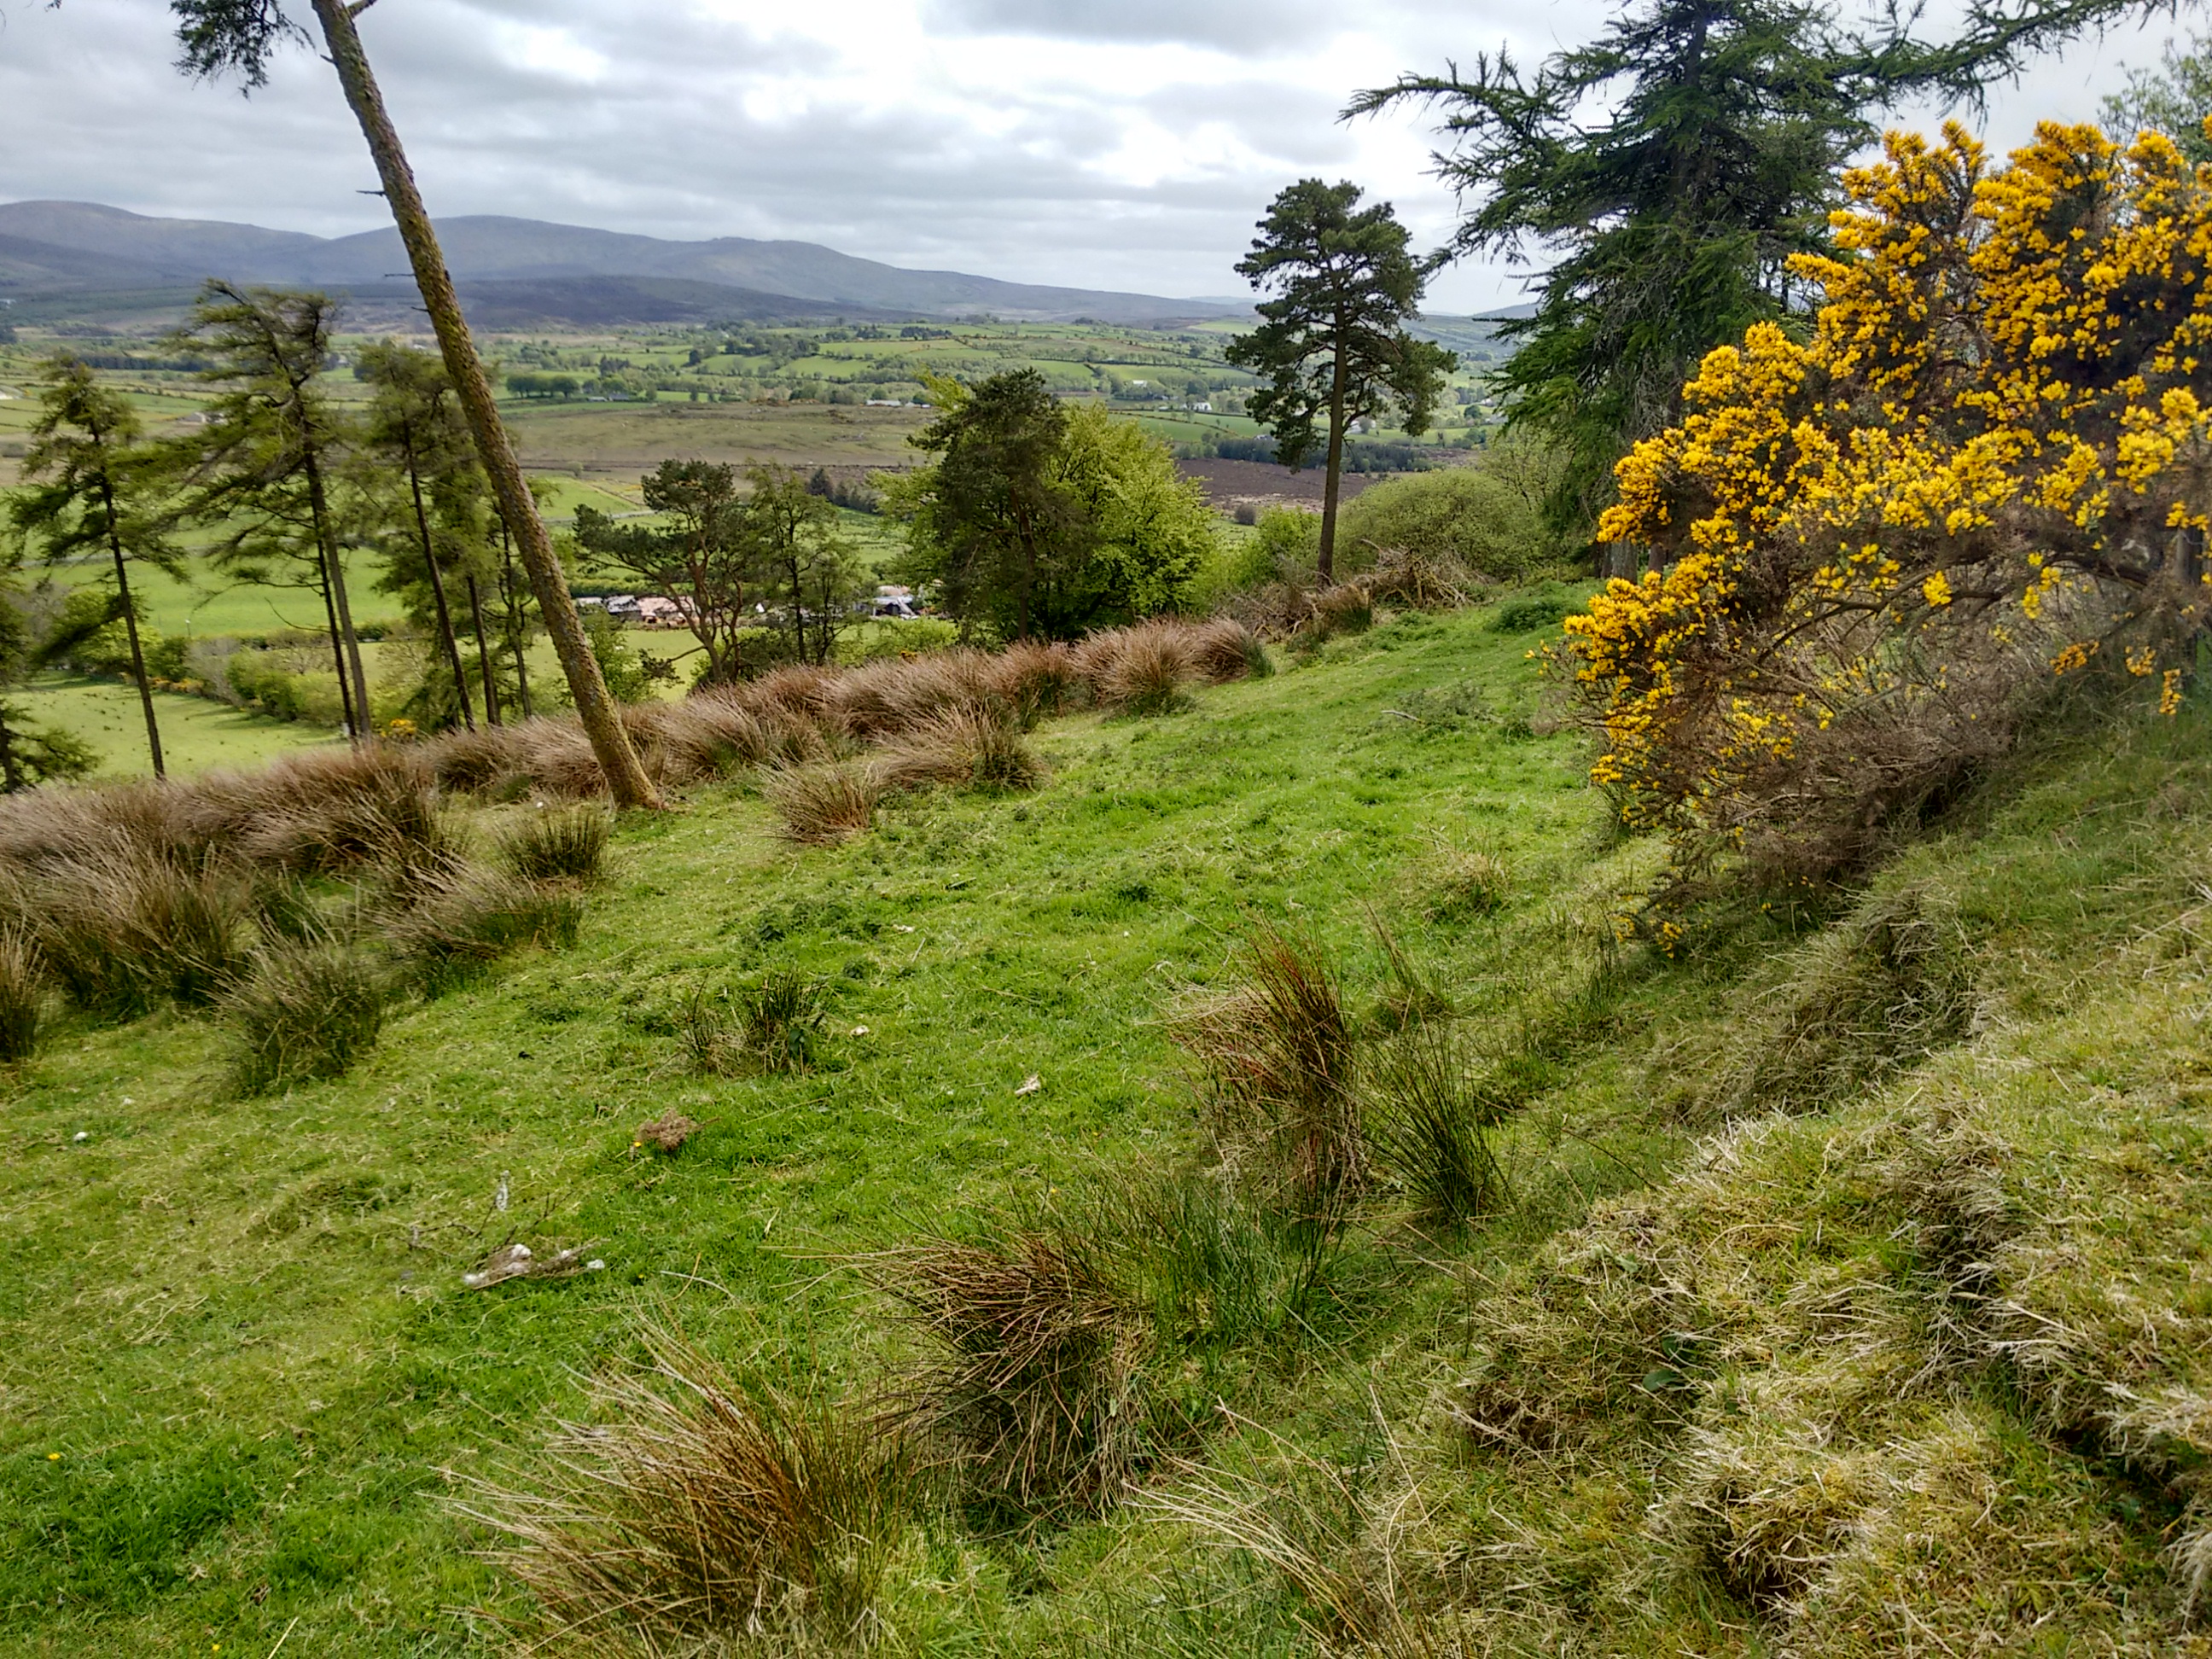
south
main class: Grassland
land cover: Grassland without tree/shrub cover
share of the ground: > 75 %
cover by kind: herbaceous plants 100 %
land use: Agriculture (excluding fallow land and kitchen gardens)
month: May
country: GB
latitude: 54.8818
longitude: -7.2130
